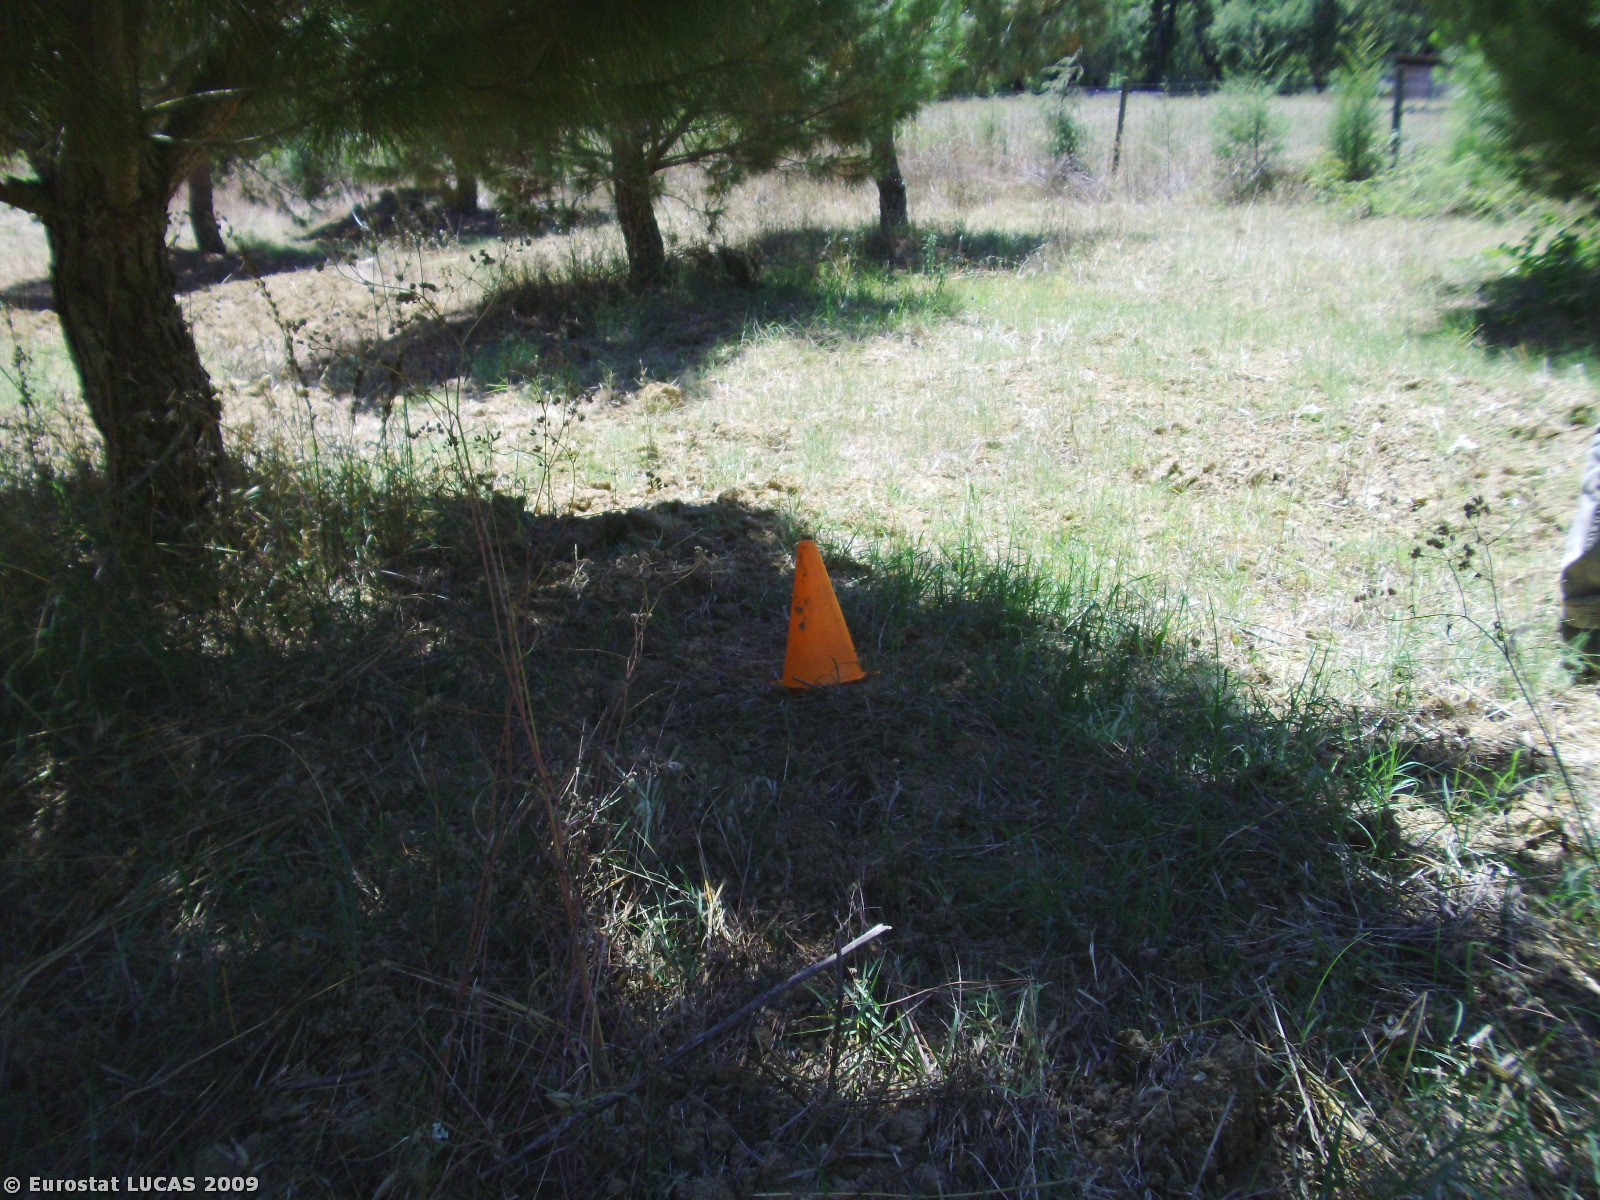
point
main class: Woodland
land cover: Coniferous woodland
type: coniferous forest of the mediterranean region
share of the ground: 10 - 25 %
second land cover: Bare land
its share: 50 - 75 %
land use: Forestry
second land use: Fallow land
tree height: > 5 m
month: July
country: PT
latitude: 39.1343
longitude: -8.8035
